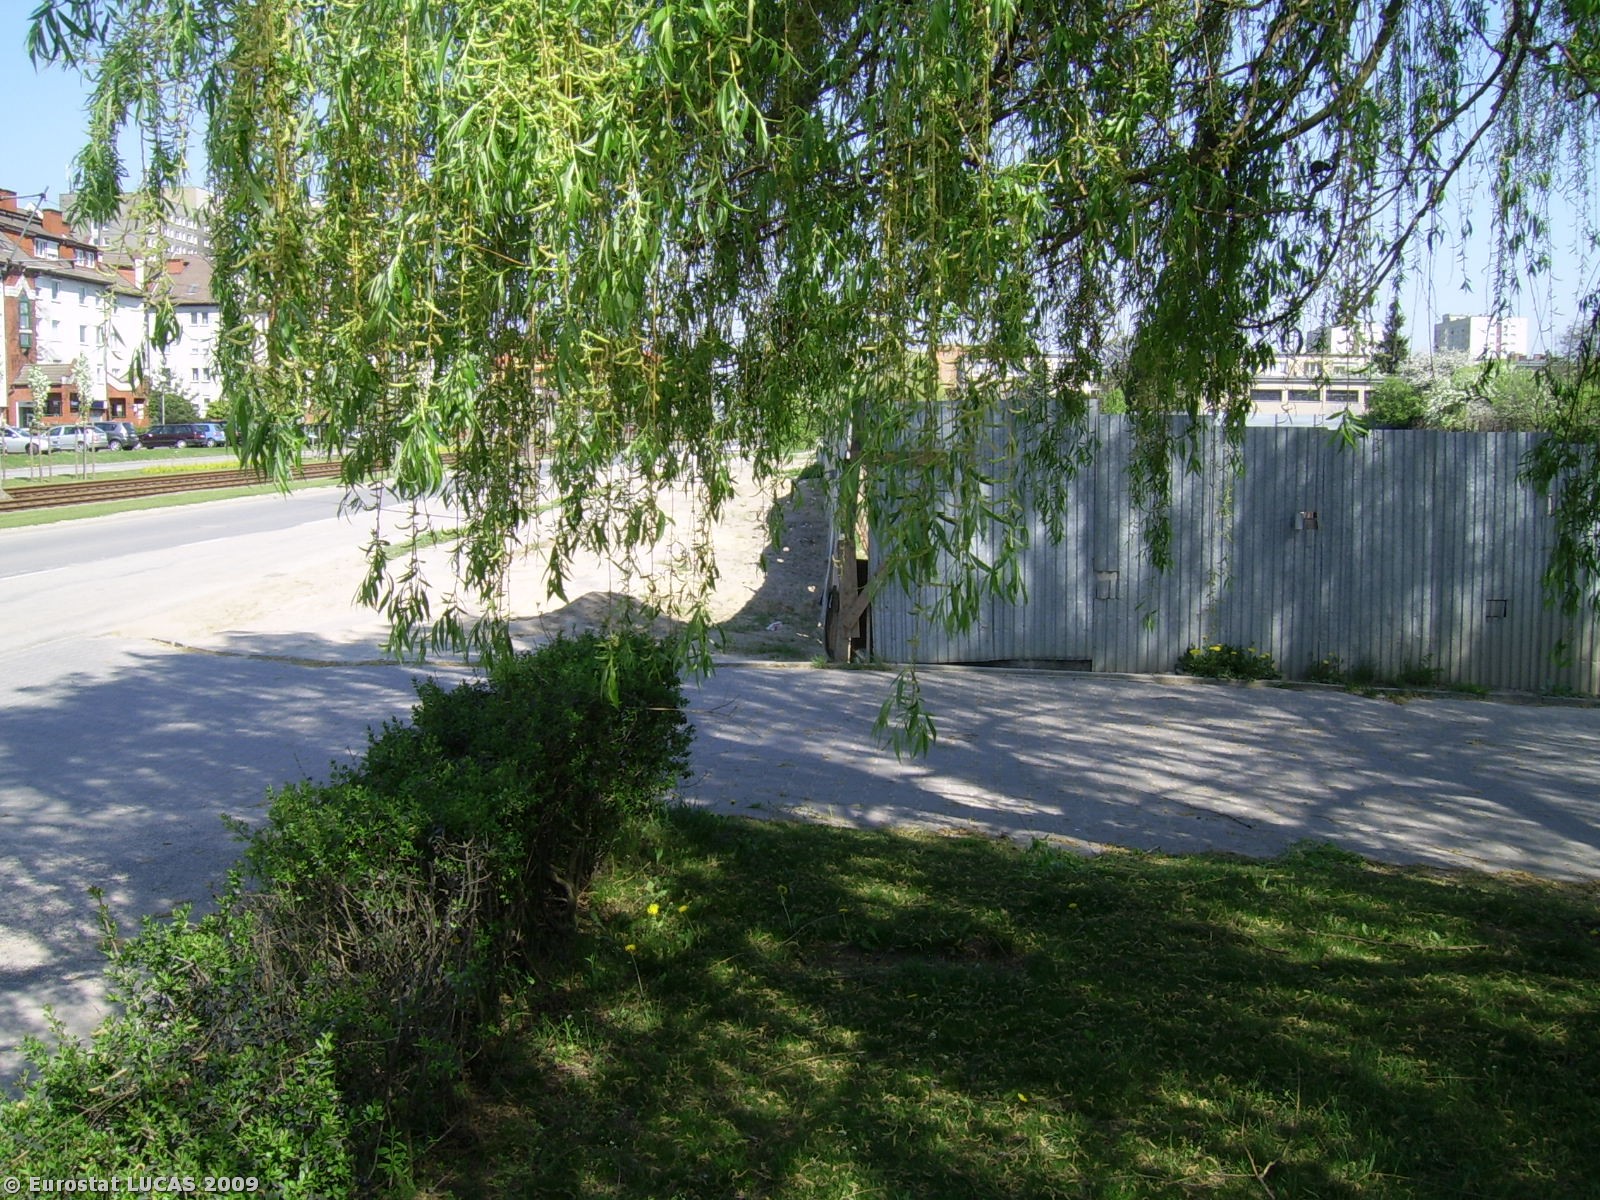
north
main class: Woodland
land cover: Broadleaved woodland
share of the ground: > 75 %
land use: Commerce, finance, business
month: April
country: PL
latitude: 52.4272
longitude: 16.9362
